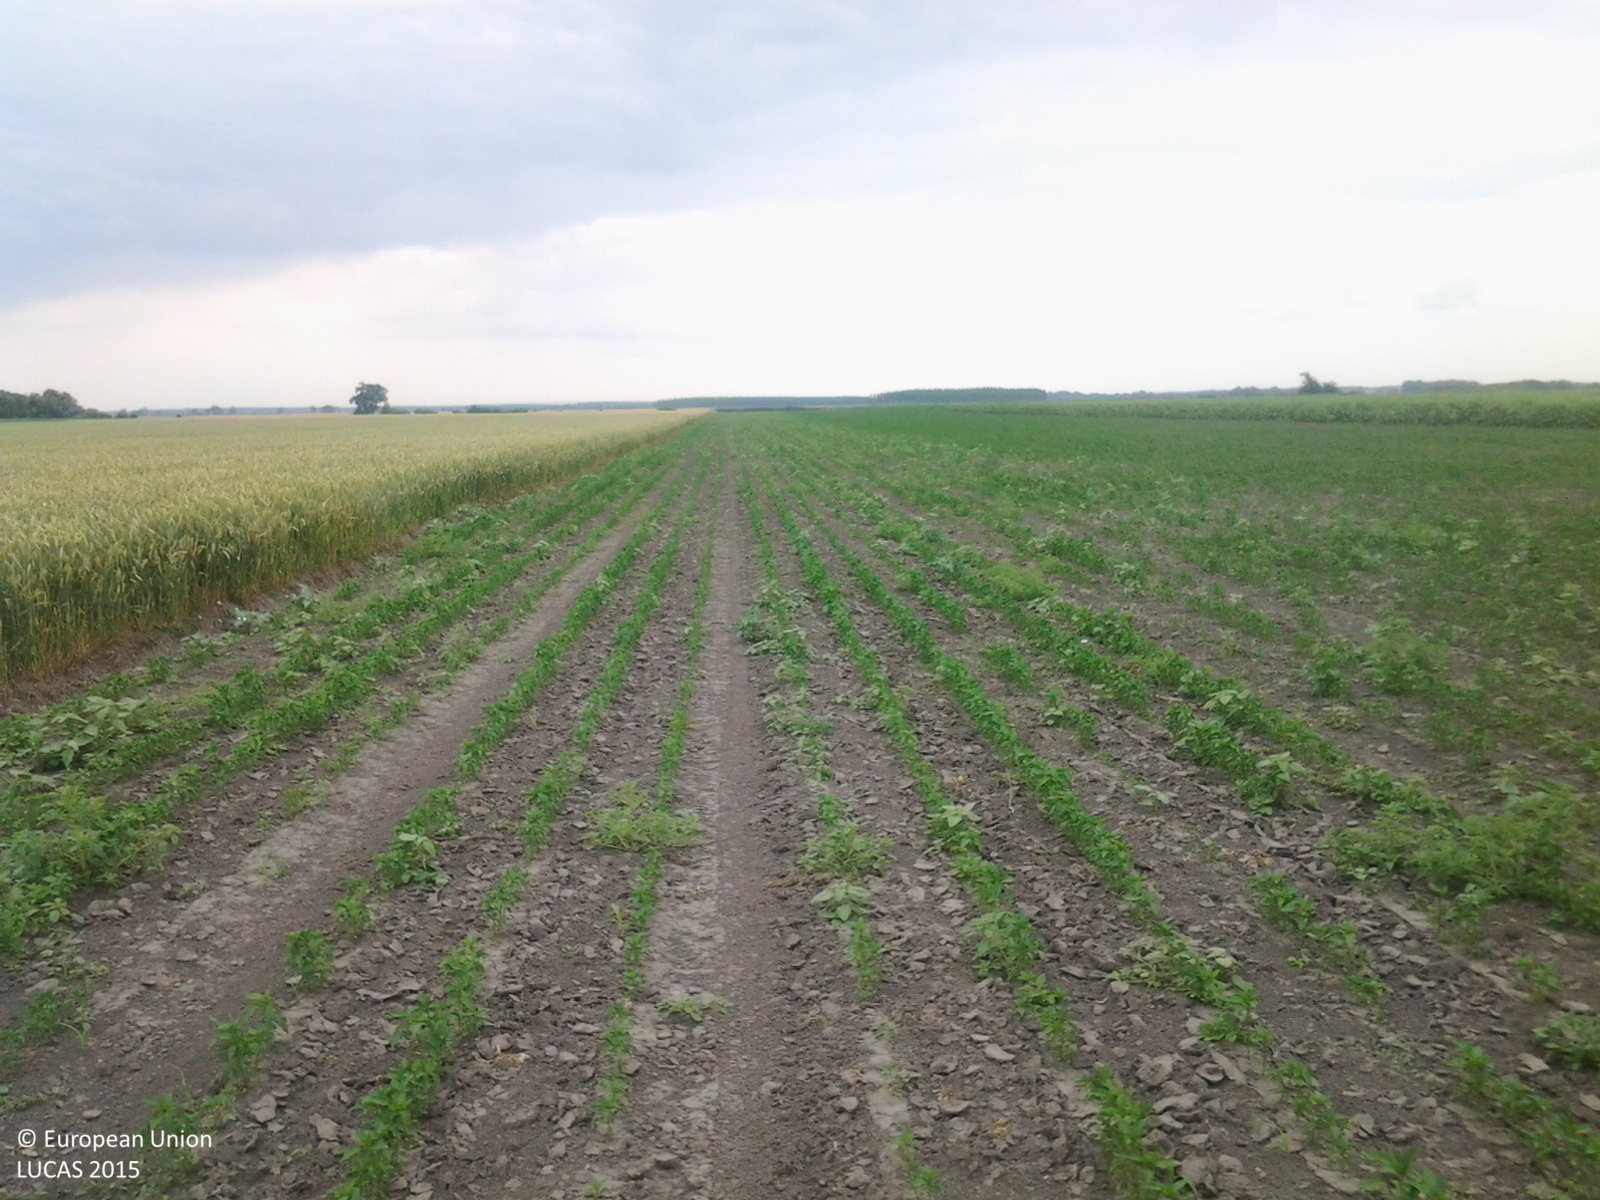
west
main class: Cropland
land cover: Other fresh vegetables
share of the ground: 25 - 50 %
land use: Agriculture (excluding fallow land and kitchen gardens)
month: June
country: HU
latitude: 46.3501
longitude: 19.0184
